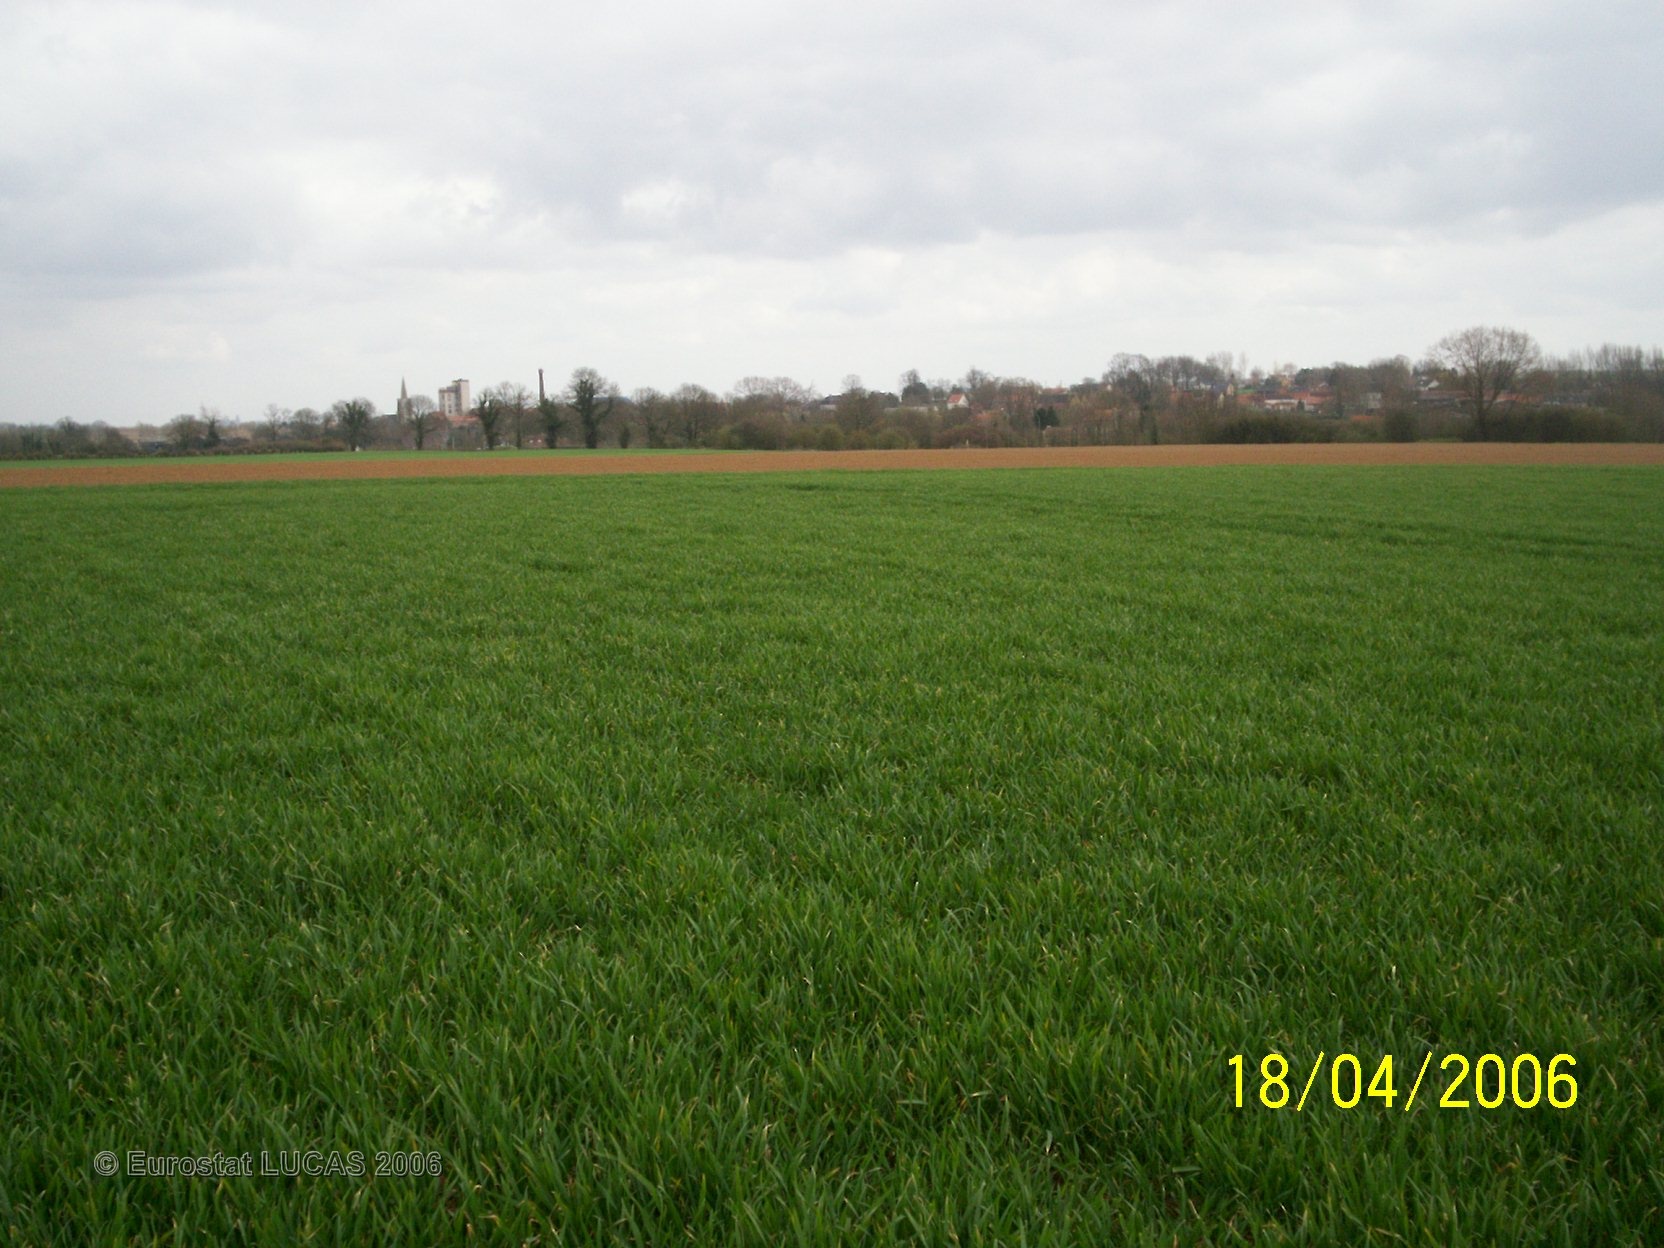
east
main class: Cropland
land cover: Common wheat
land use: Agriculture (excluding fallow land and kitchen gardens)
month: April
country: FR
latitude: 50.3559
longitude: 2.5524
